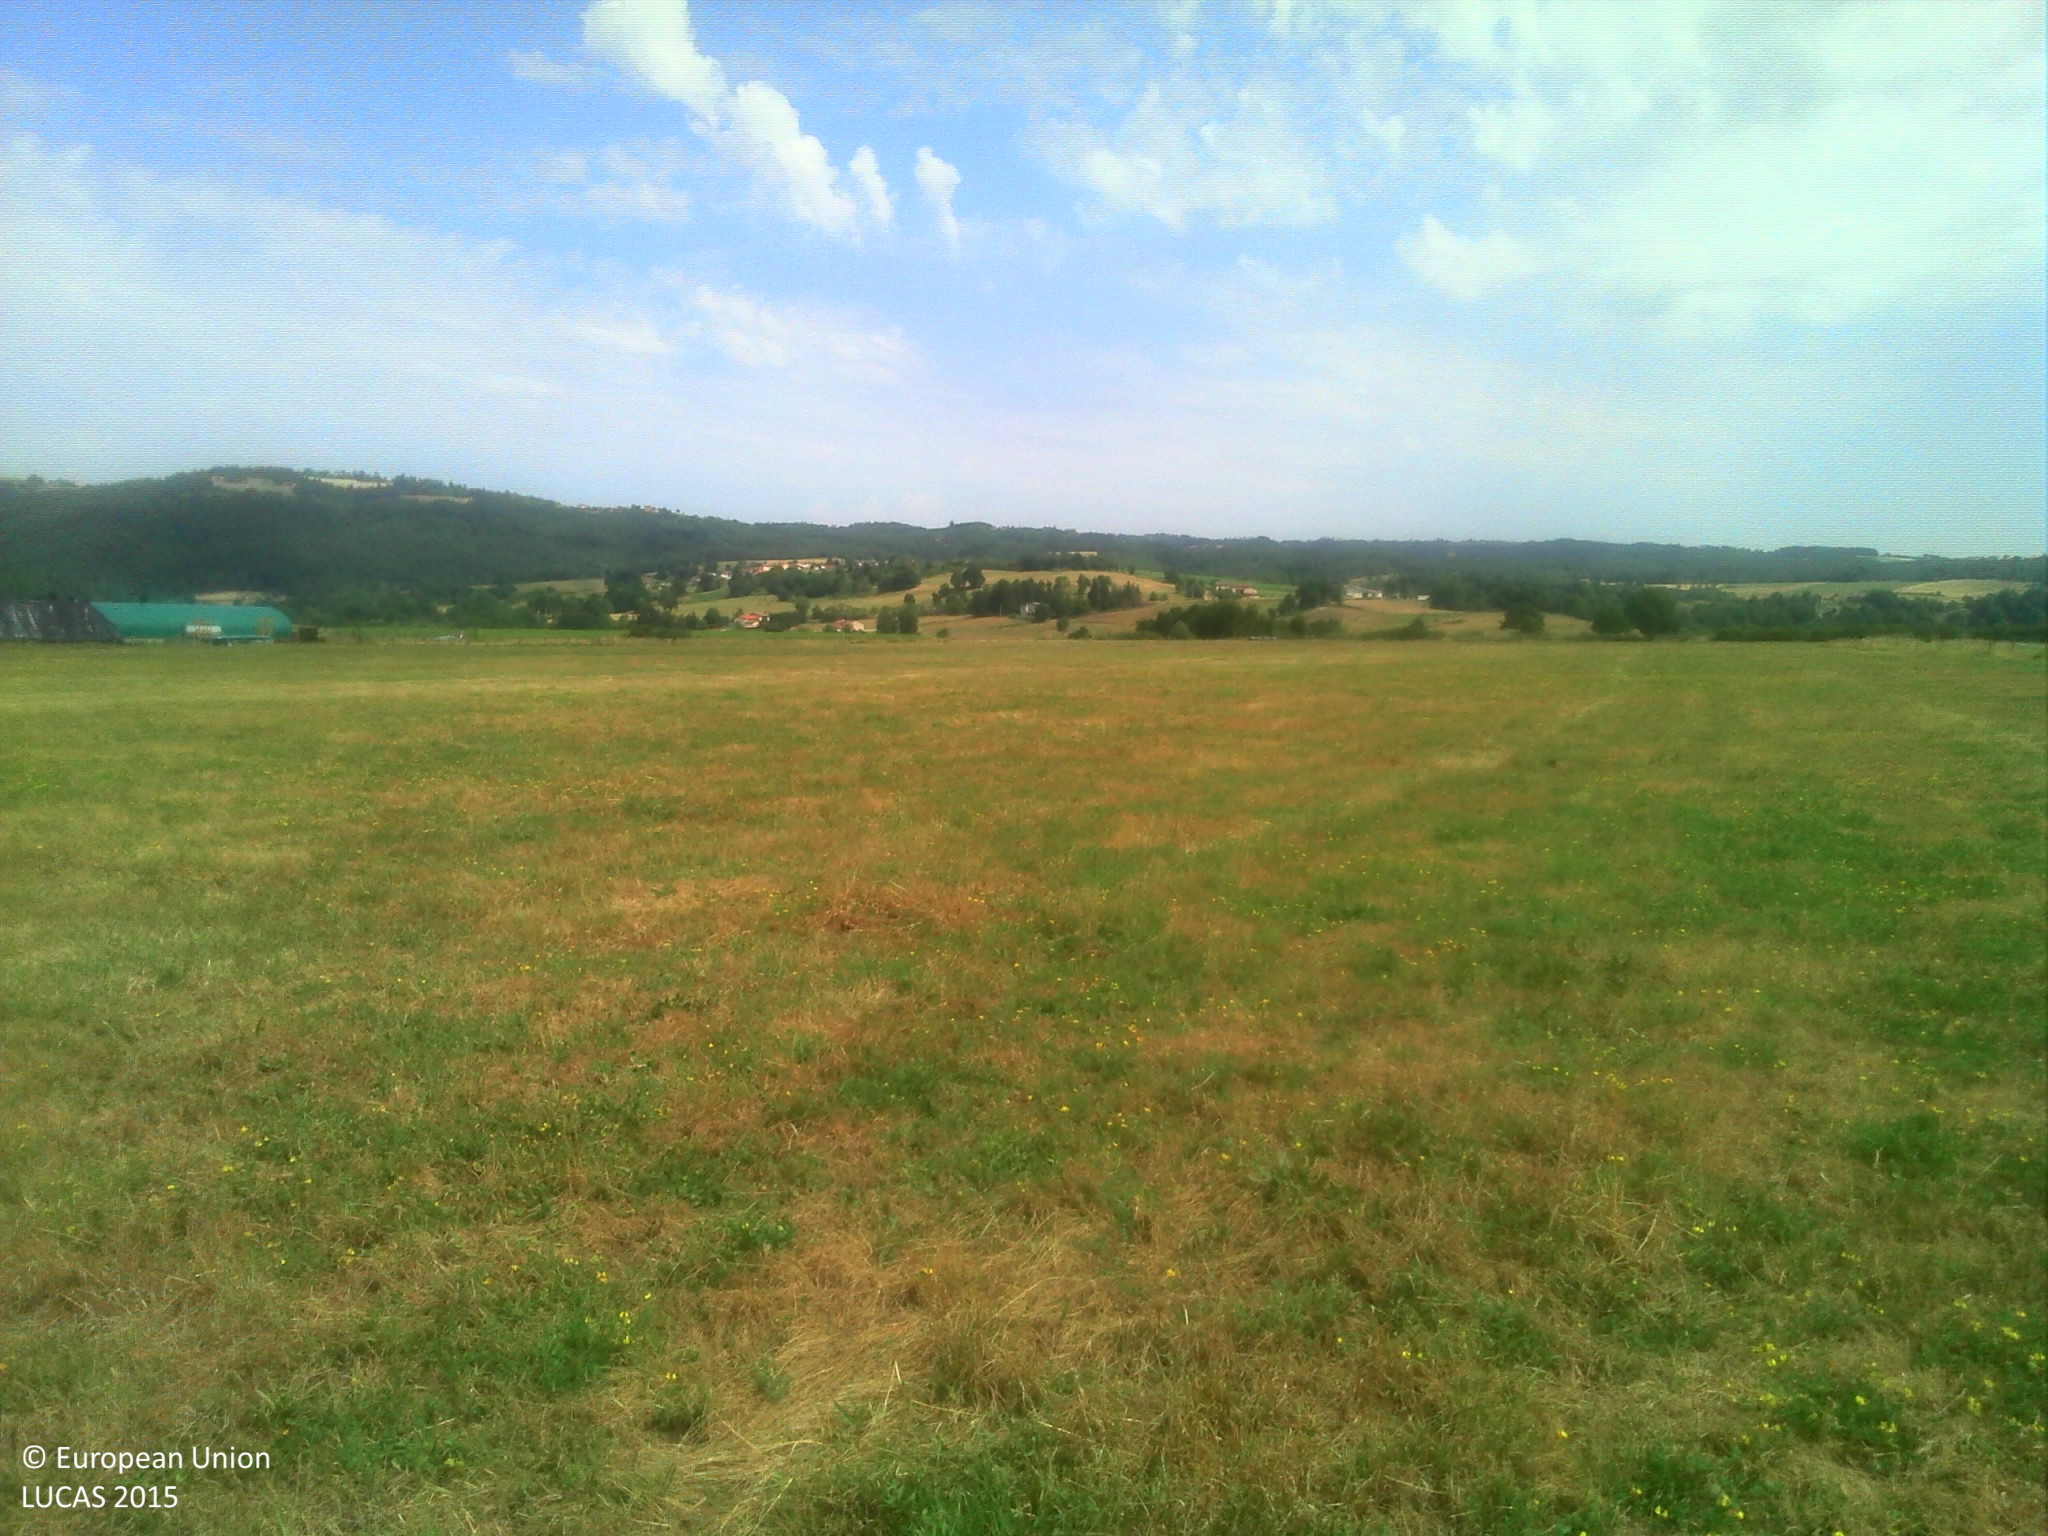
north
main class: Grassland
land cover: Grassland without tree/shrub cover
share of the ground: > 75 %
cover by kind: herbaceous plants 100 %
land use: Agriculture (excluding fallow land and kitchen gardens)
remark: Harvested field
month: July
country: FR
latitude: 45.3240
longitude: 4.1478
